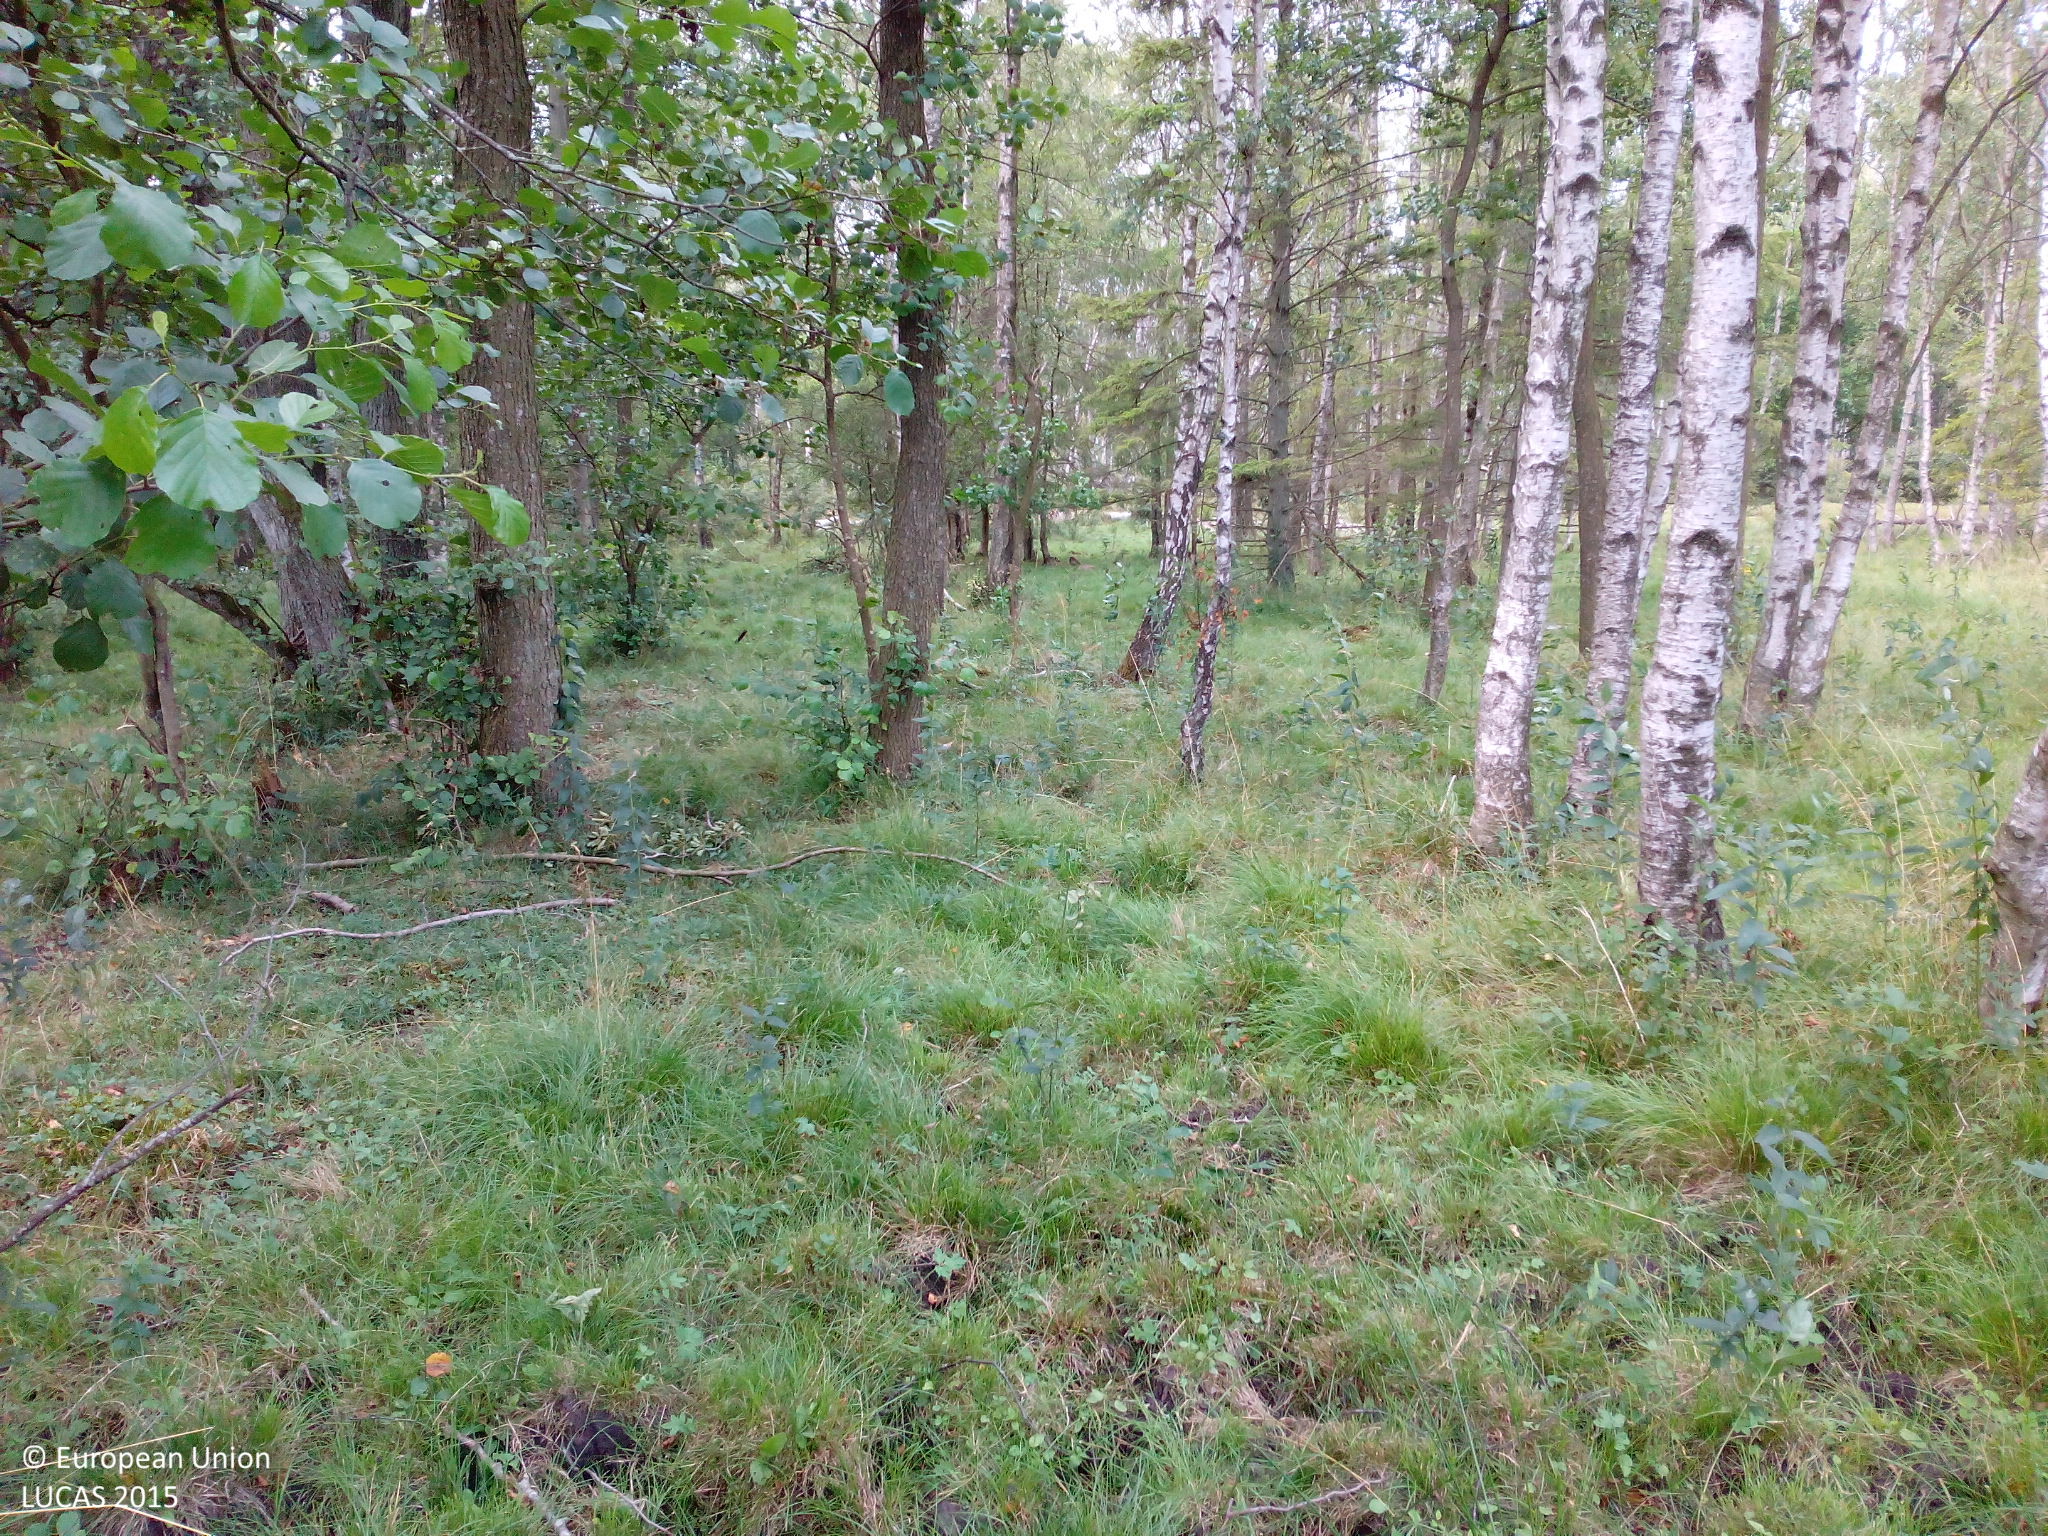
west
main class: Woodland
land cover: Broadleaved woodland
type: beech forest
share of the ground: 50 - 75 %
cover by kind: broadleaved forest trees 55 %, herbaceous plants 35 %, lichens and mosses 10 %
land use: Agriculture (excluding fallow land and kitchen gardens)
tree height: > 5 m
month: August
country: DK
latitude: 55.0997
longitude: 14.9998
